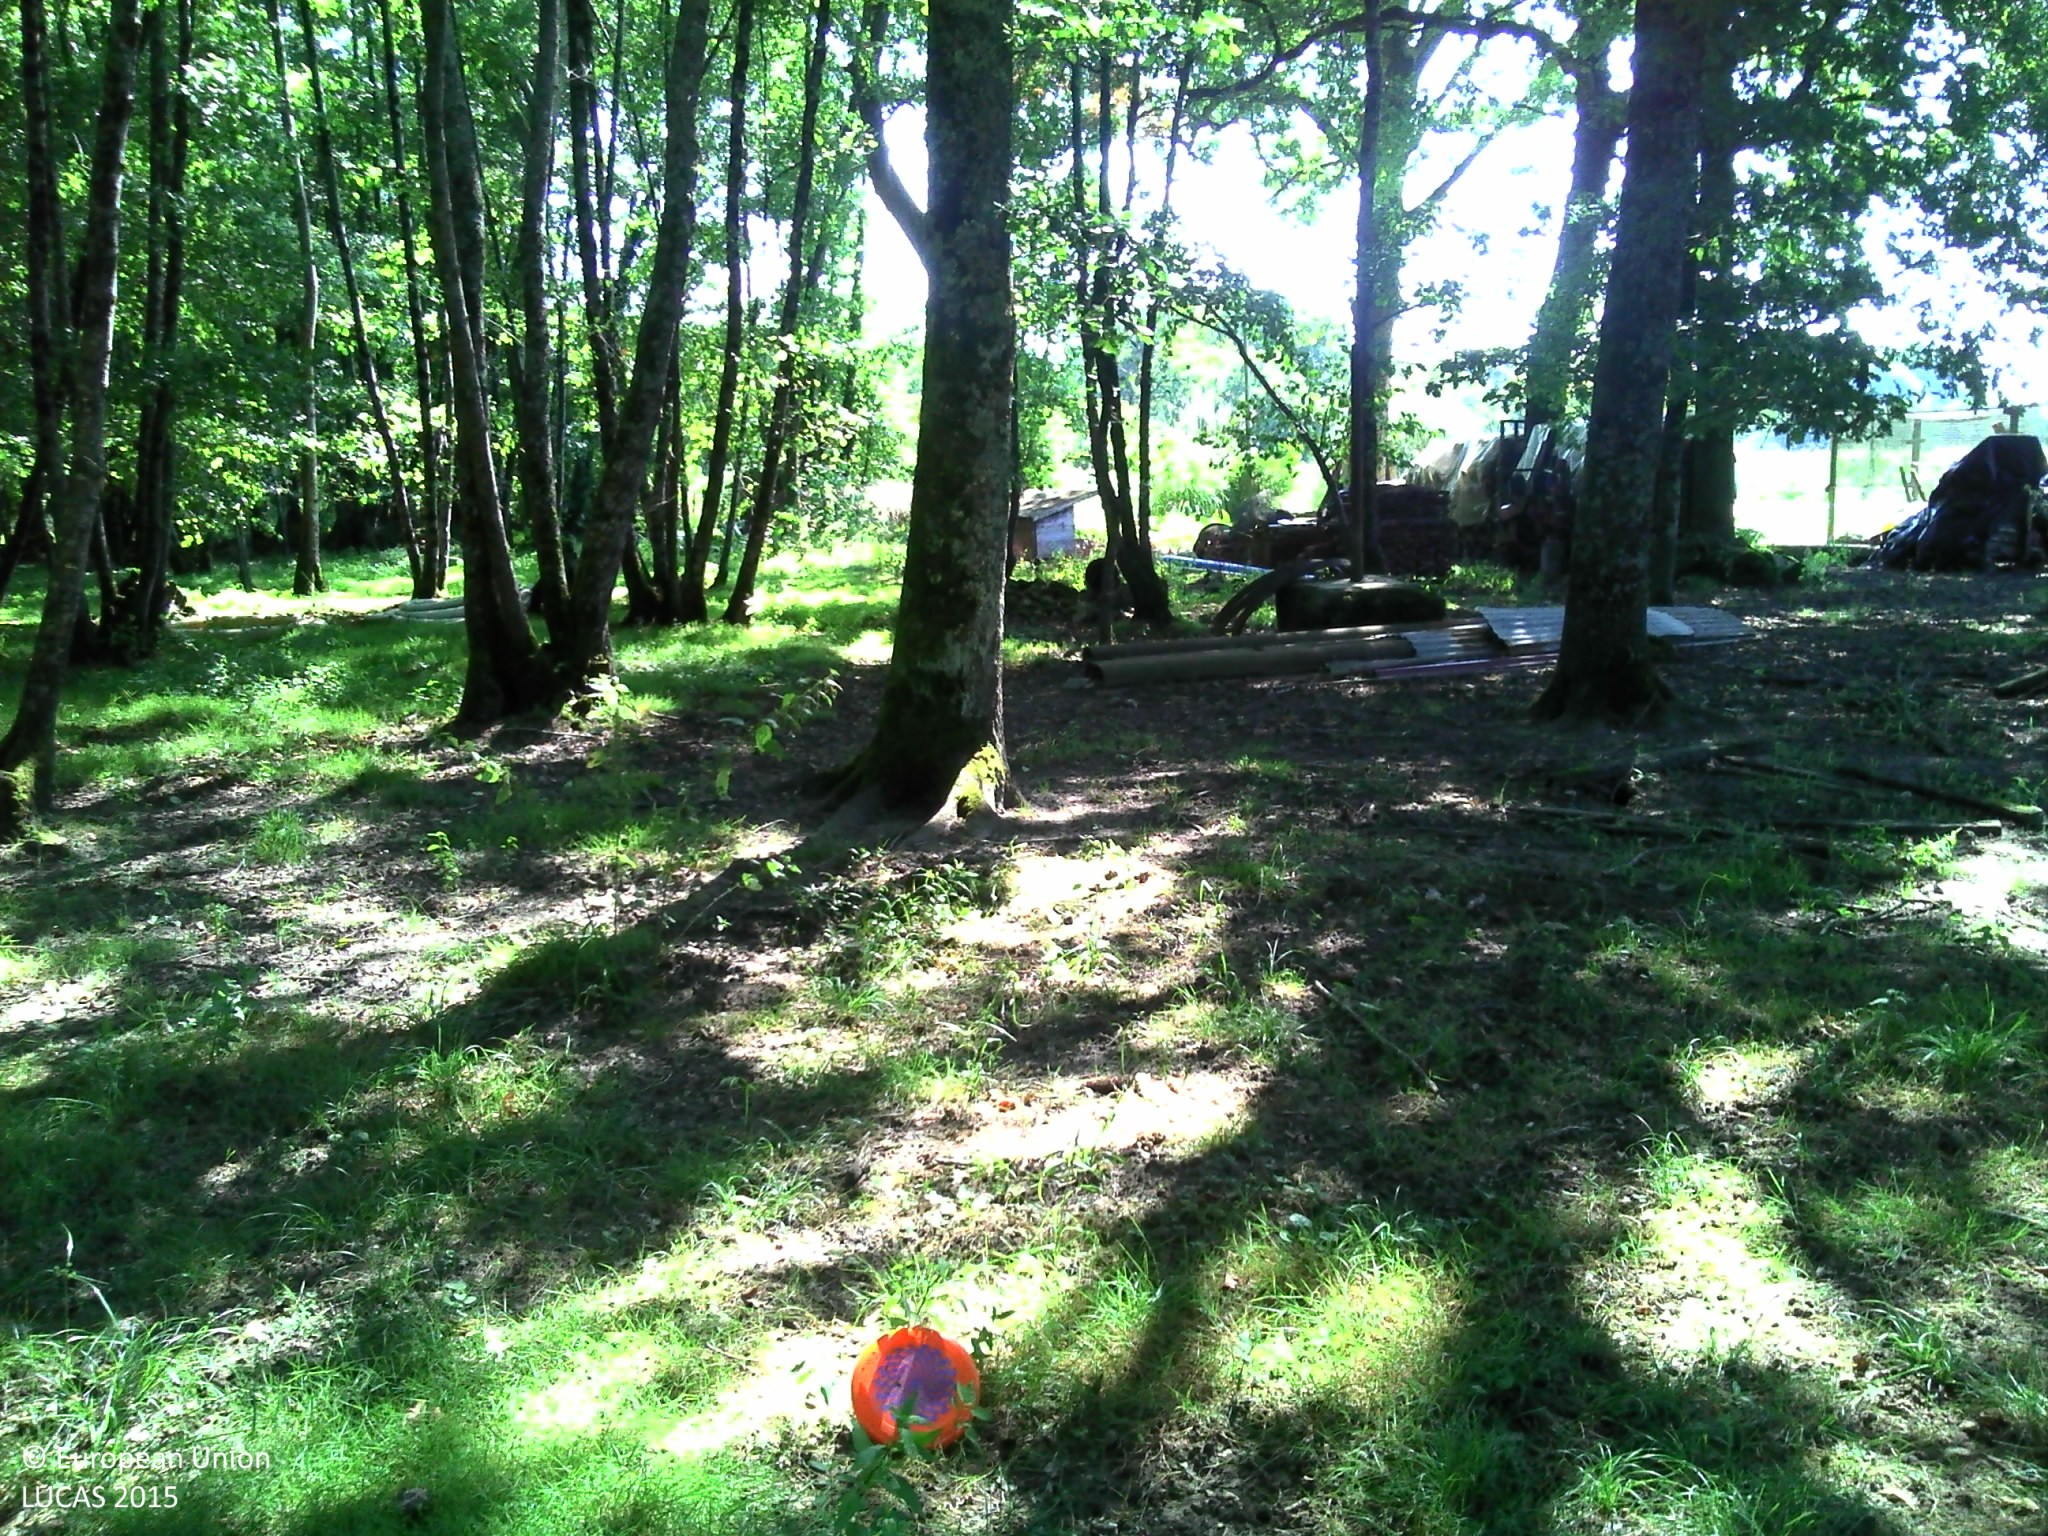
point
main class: Woodland
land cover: Broadleaved woodland
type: mesophytic deciduous forest
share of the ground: > 75 %
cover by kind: broadleaved forest trees 60 %, herbaceous plants 35 %, lichens and mosses 5 %
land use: Forestry
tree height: > 5 m
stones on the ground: < 10 %
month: August
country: FR
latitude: 43.7739
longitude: -0.7349
